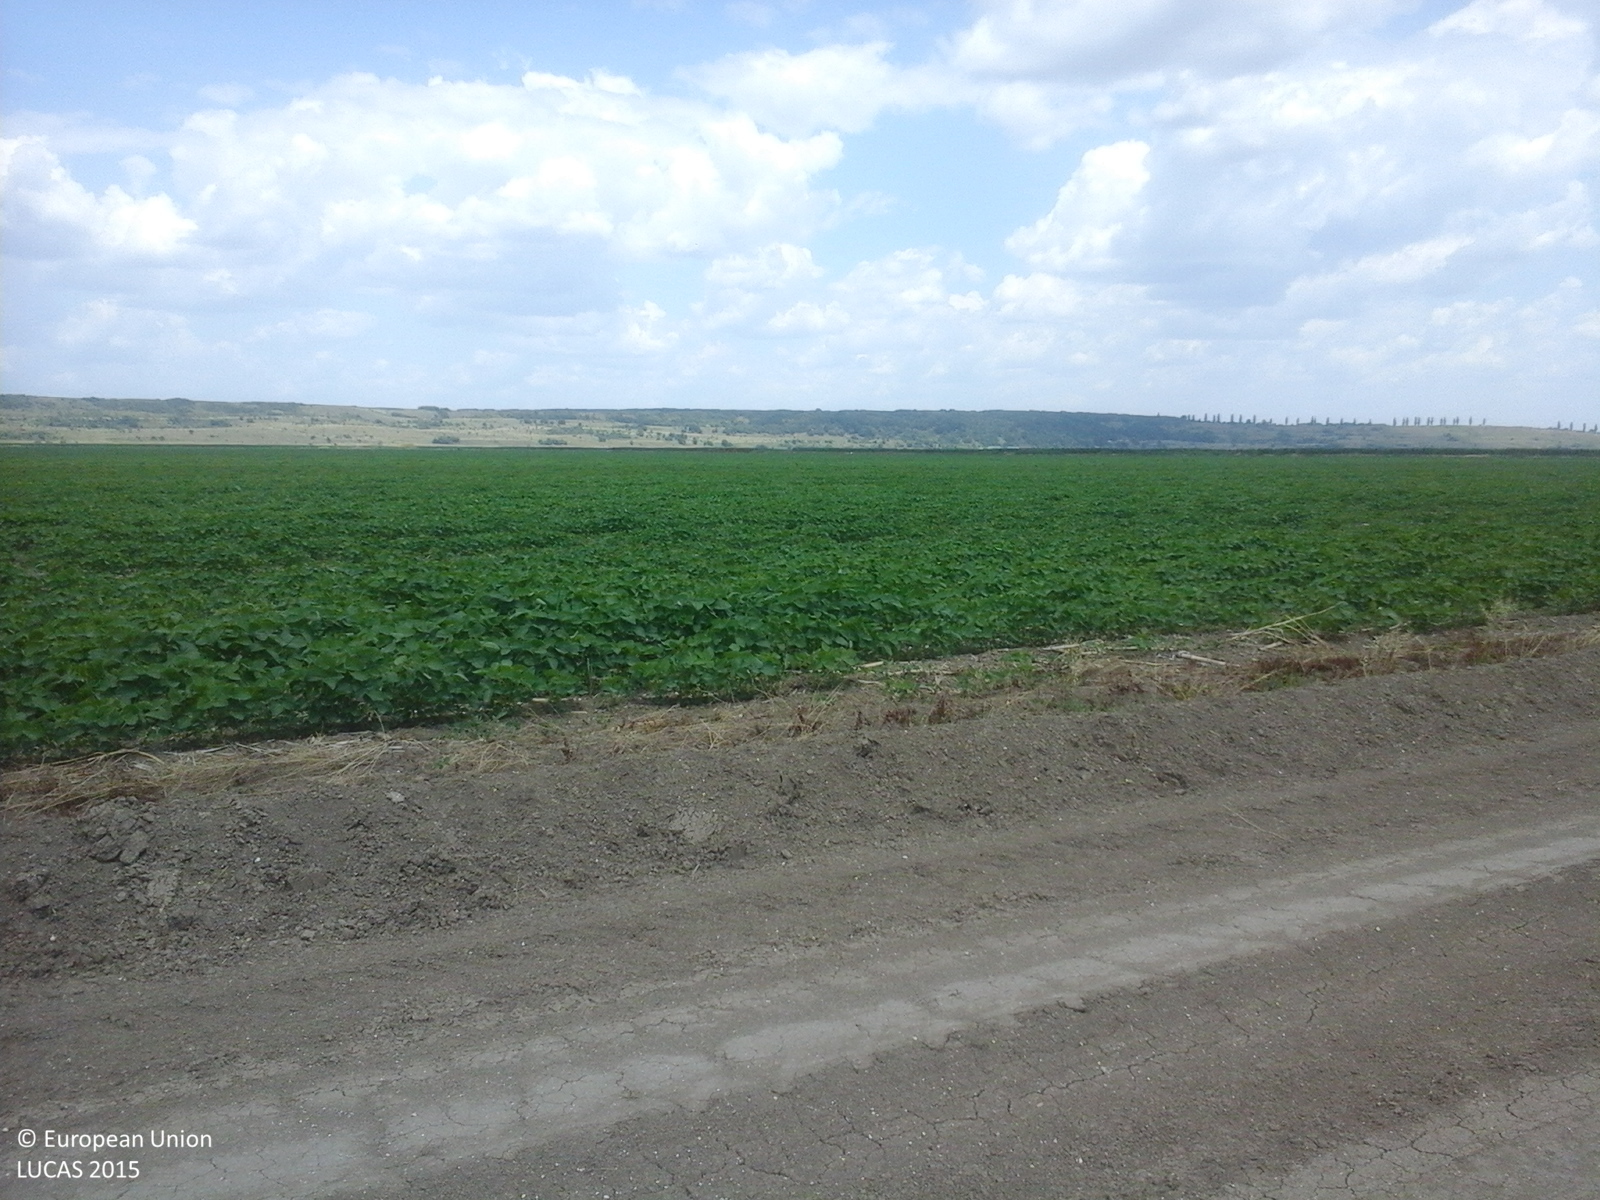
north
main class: Cropland
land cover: Soya
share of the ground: > 75 %
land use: Agriculture (excluding fallow land and kitchen gardens)
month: June
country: RO
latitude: 44.1029
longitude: 26.3863
